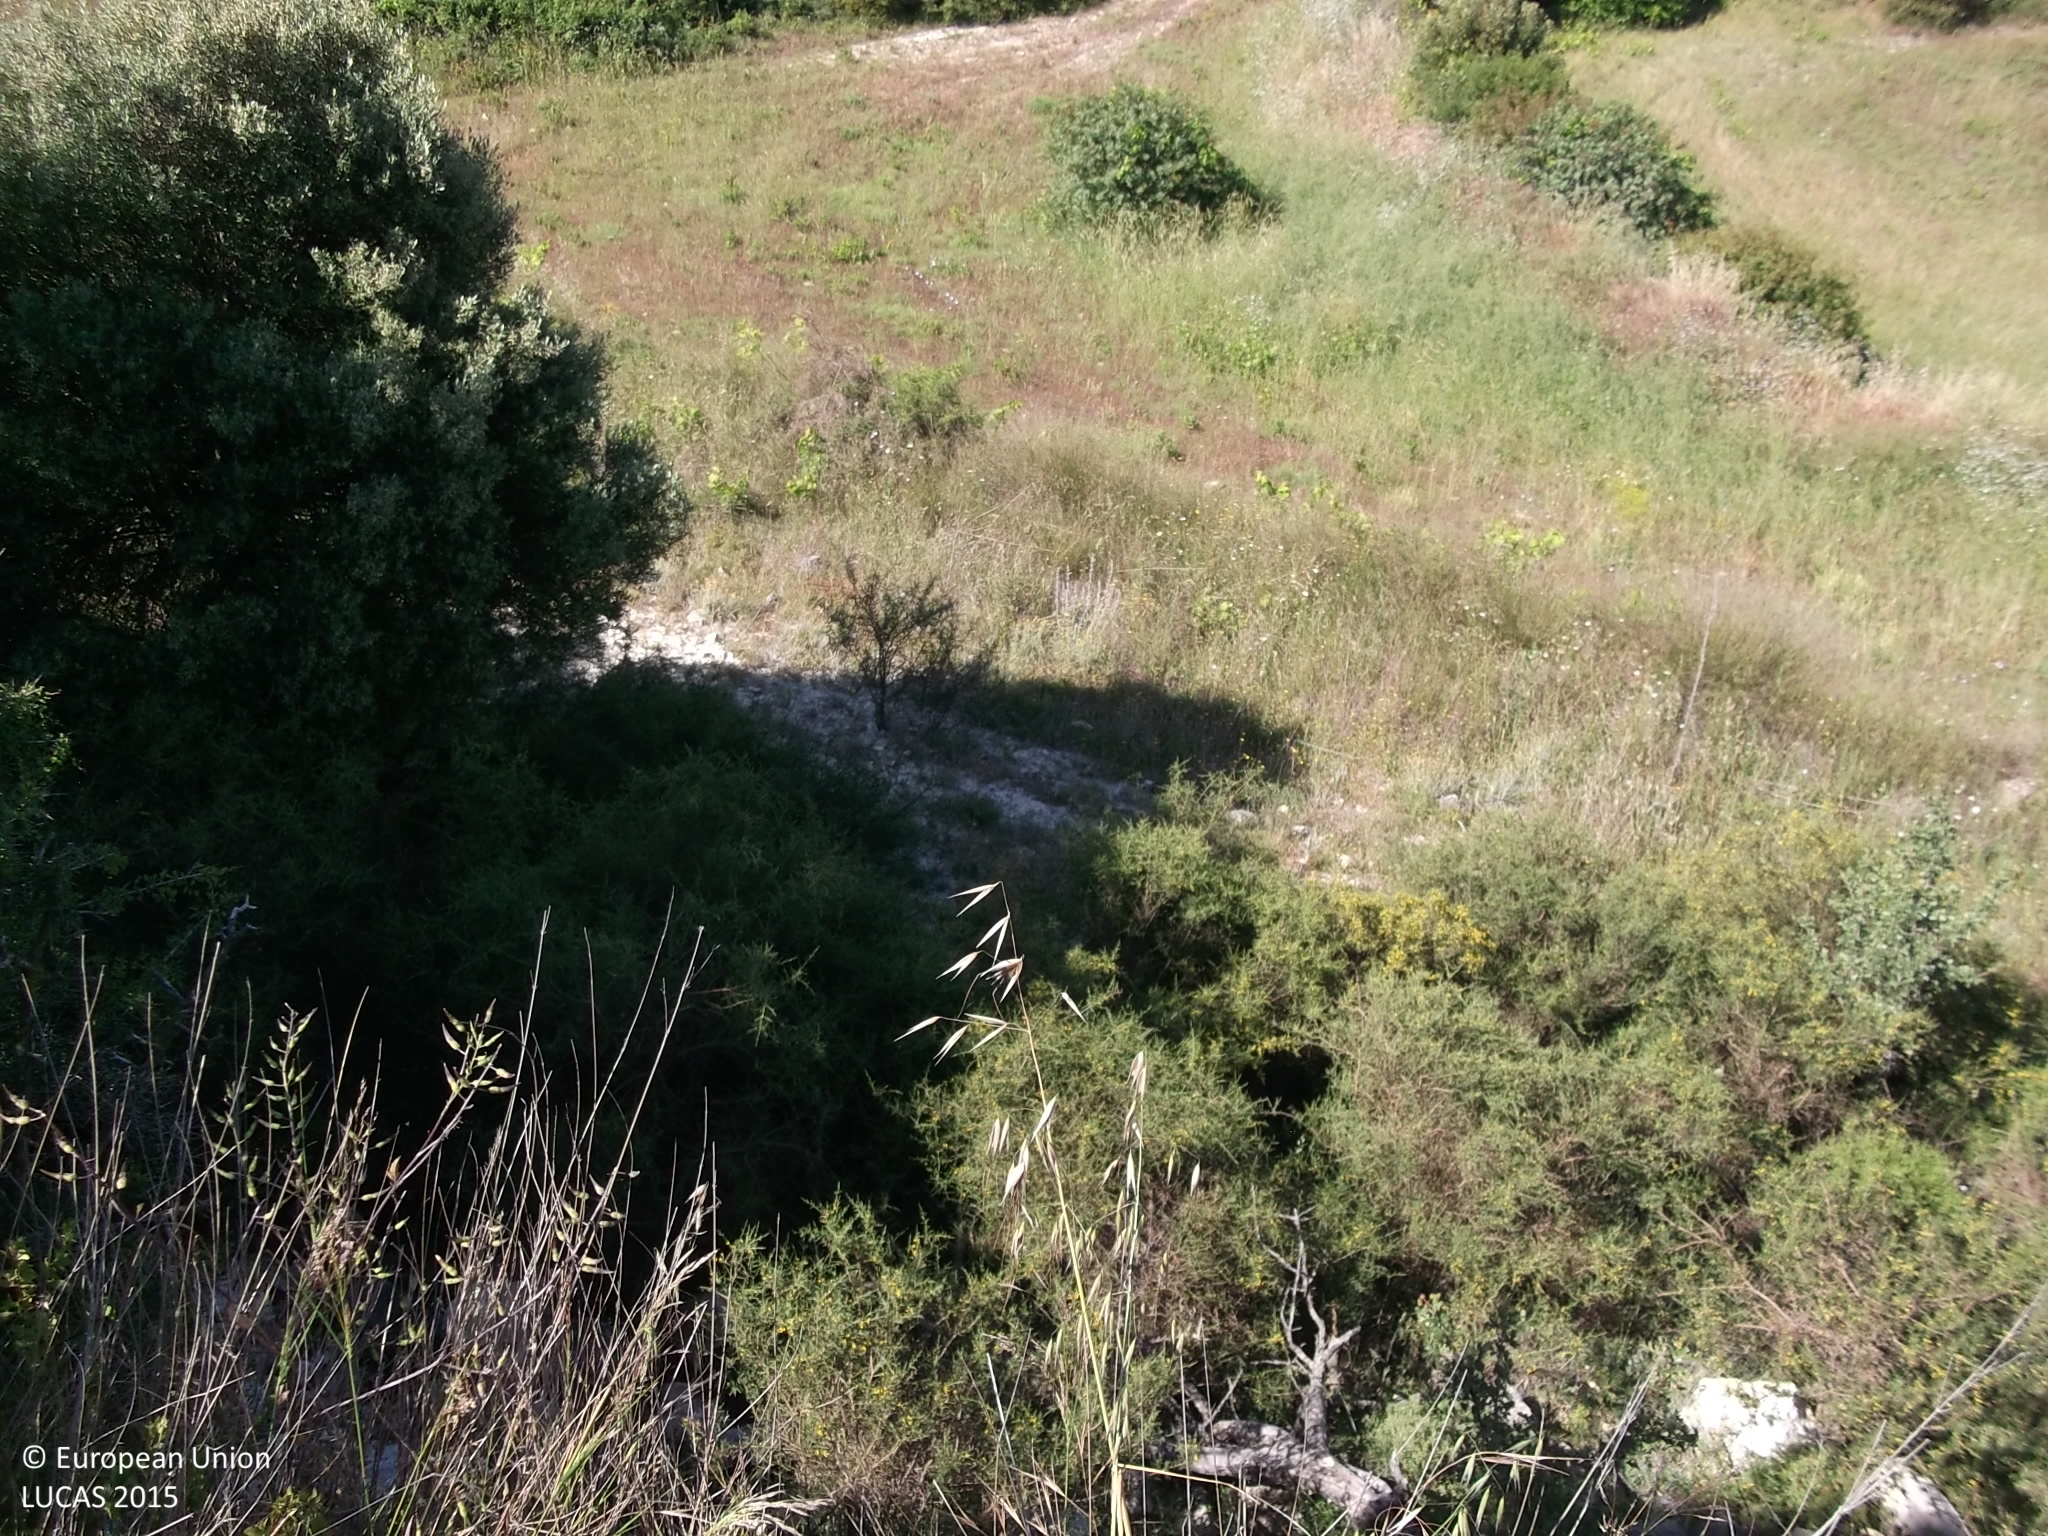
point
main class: Shrubland
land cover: Shrubland with sparse tree cover
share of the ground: > 75 %
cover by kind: shrubs 75 %, unconsolidated bare surface 20 %, broadleaved forest trees 5 %
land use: Semi-natural and natural areas not in use
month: May
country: CY
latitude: 34.7967
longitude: 32.5450
